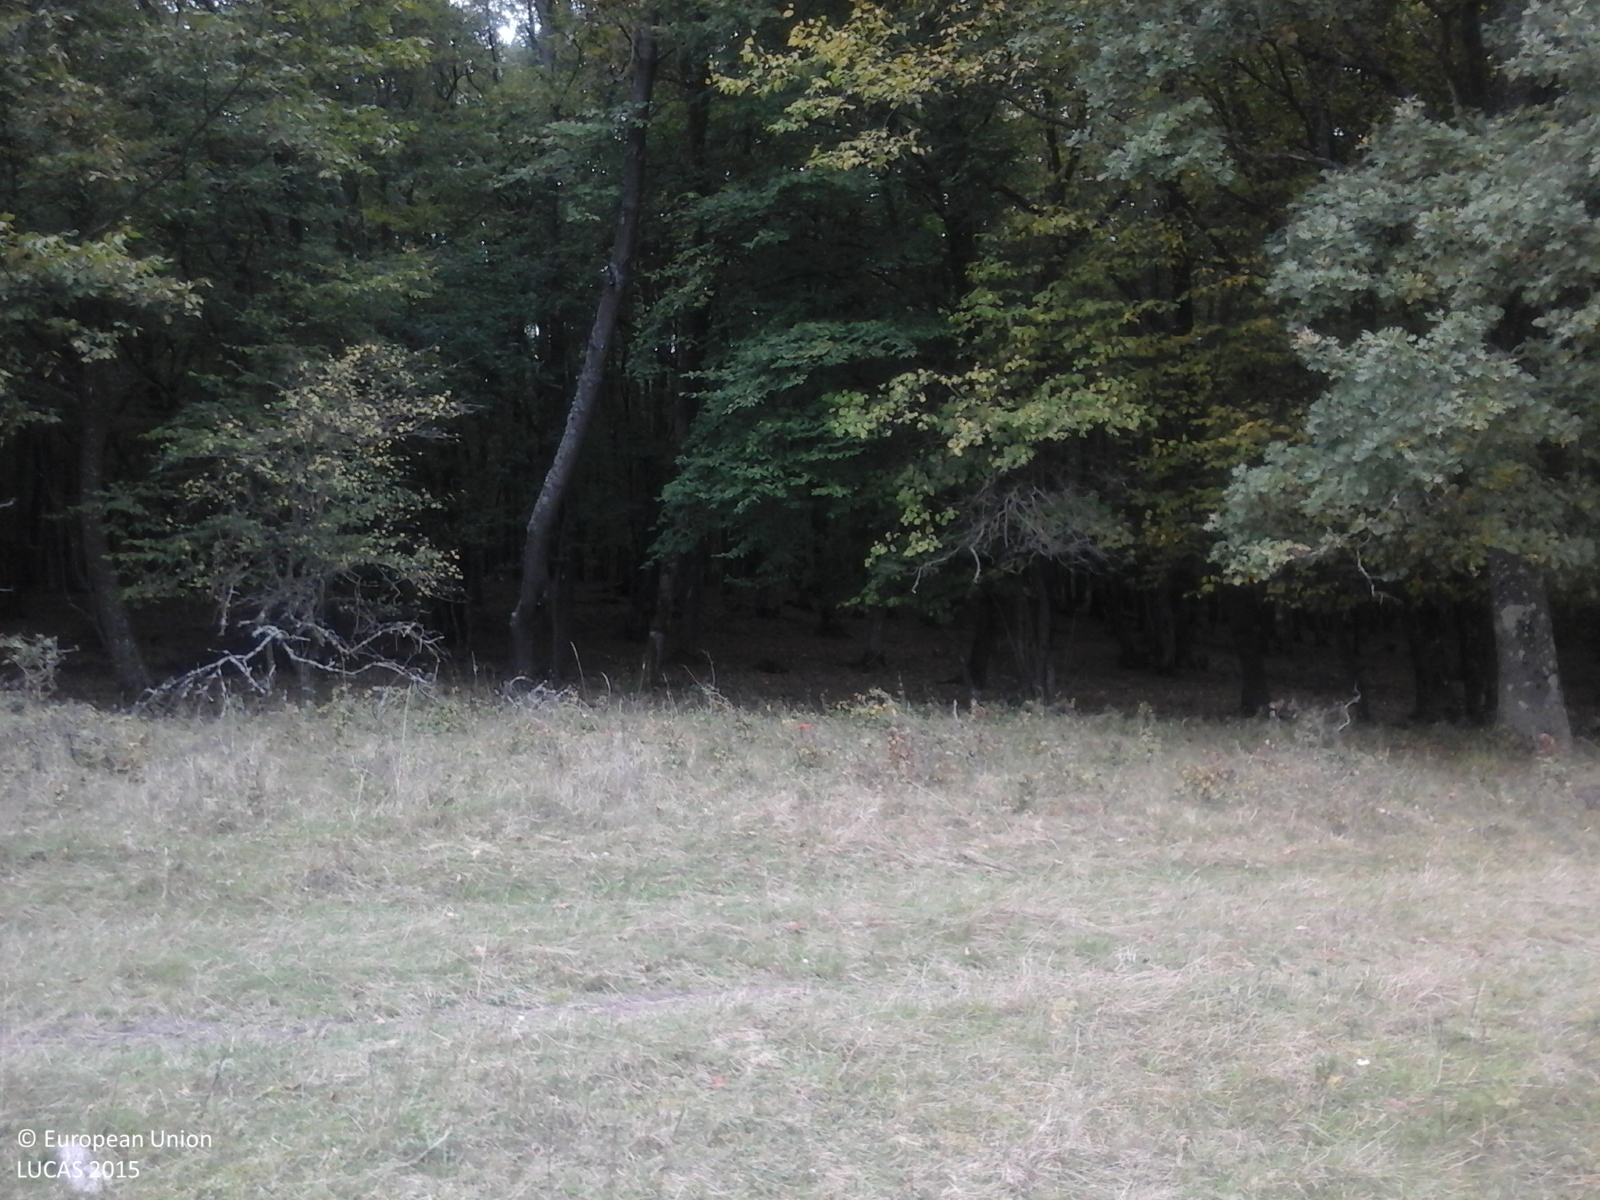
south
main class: Grassland
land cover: Grassland without tree/shrub cover
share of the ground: > 75 %
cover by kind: herbaceous plants 100 %
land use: Agriculture (excluding fallow land and kitchen gardens)
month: October
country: RO
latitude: 46.0965
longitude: 25.2203
